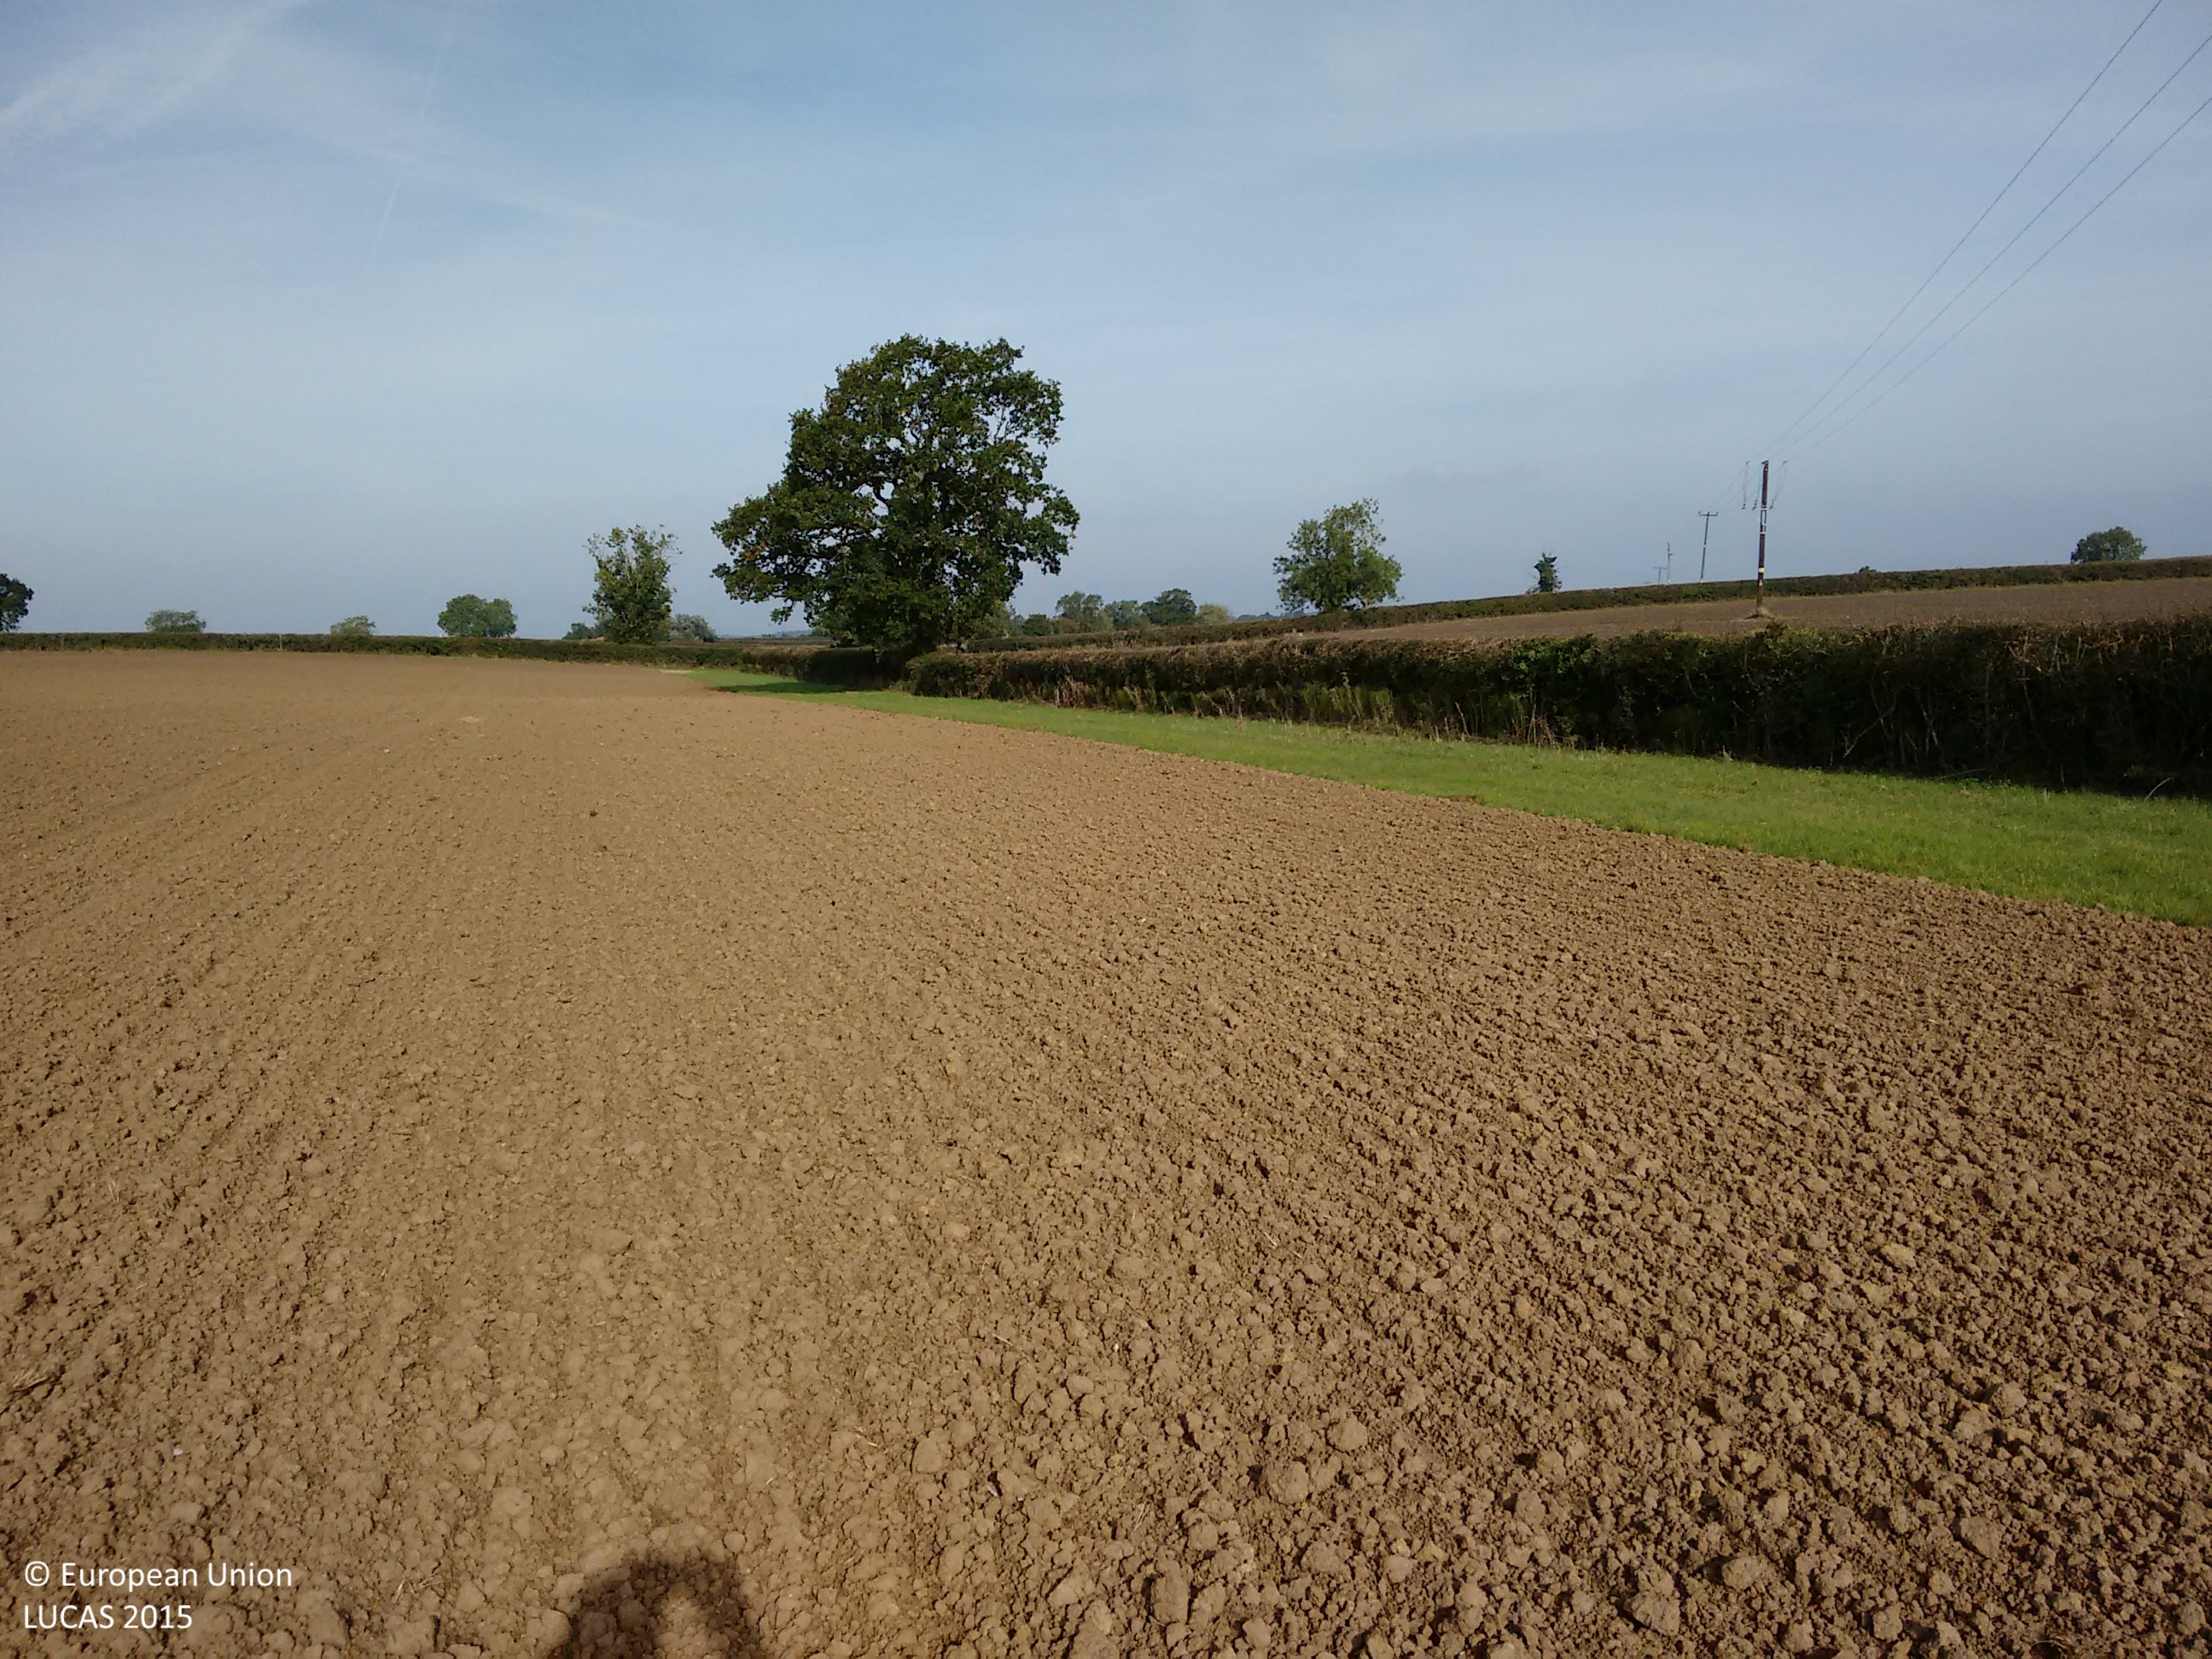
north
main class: Cropland
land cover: Barley
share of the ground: < 10 %
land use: Agriculture (excluding fallow land and kitchen gardens)
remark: Tilled/Sowed
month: September
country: GB
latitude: 51.5783
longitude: -2.4028
